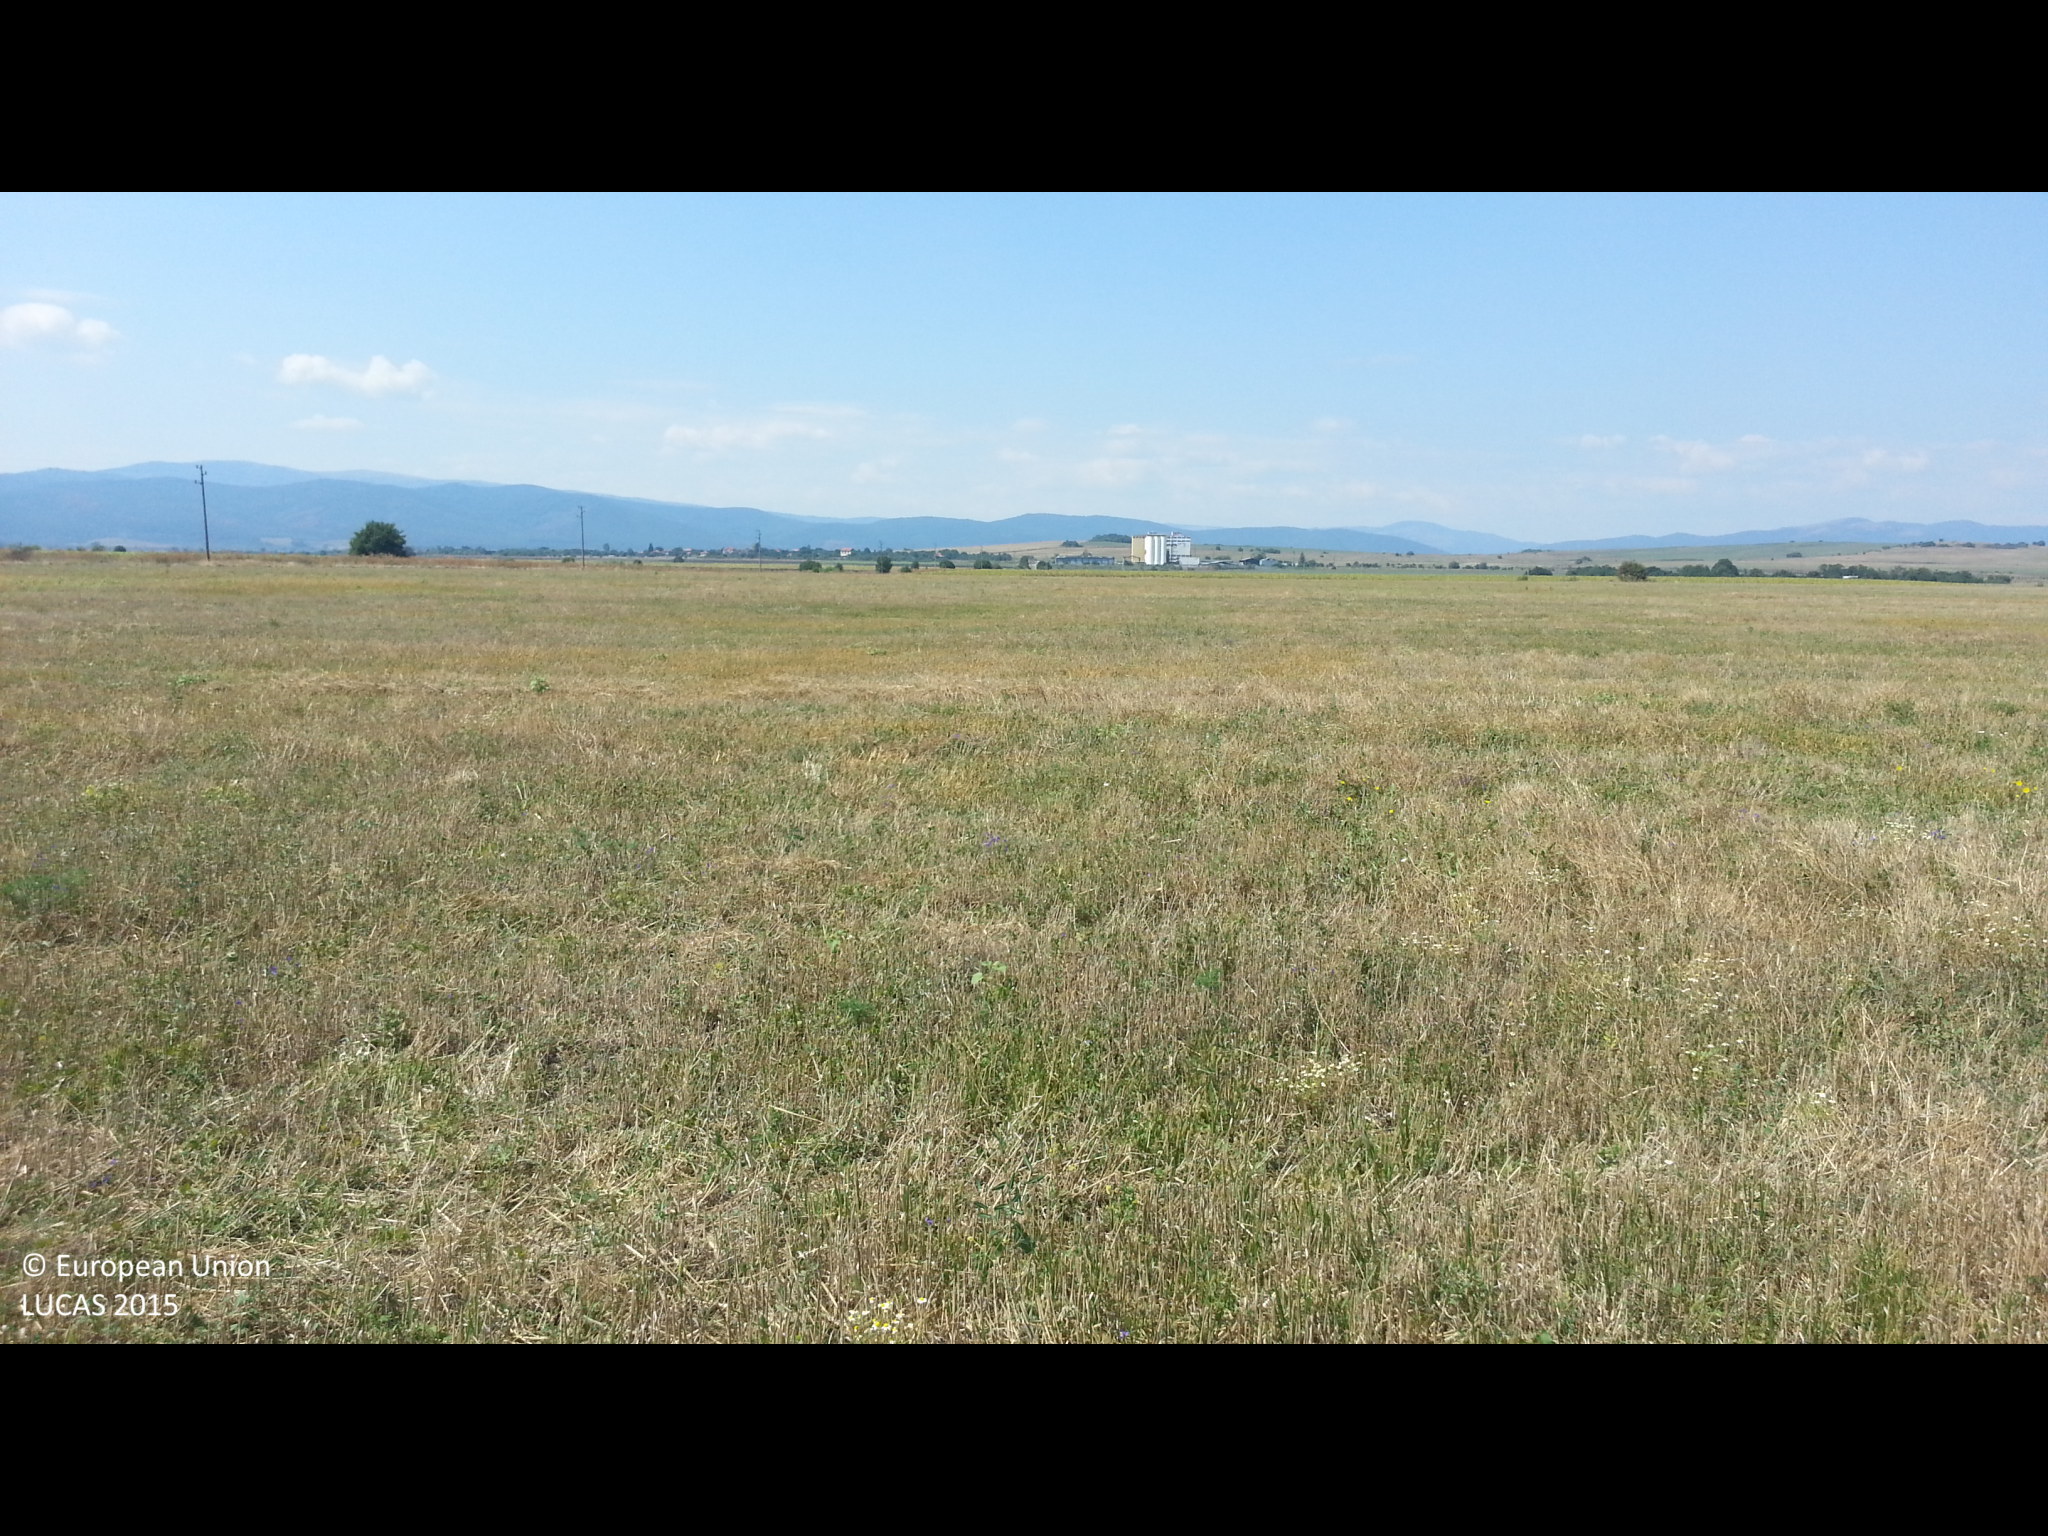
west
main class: Cropland
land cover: Common wheat
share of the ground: > 75 %
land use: Agriculture (excluding fallow land and kitchen gardens)
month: August
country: BG
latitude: 42.4608
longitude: 22.9293
